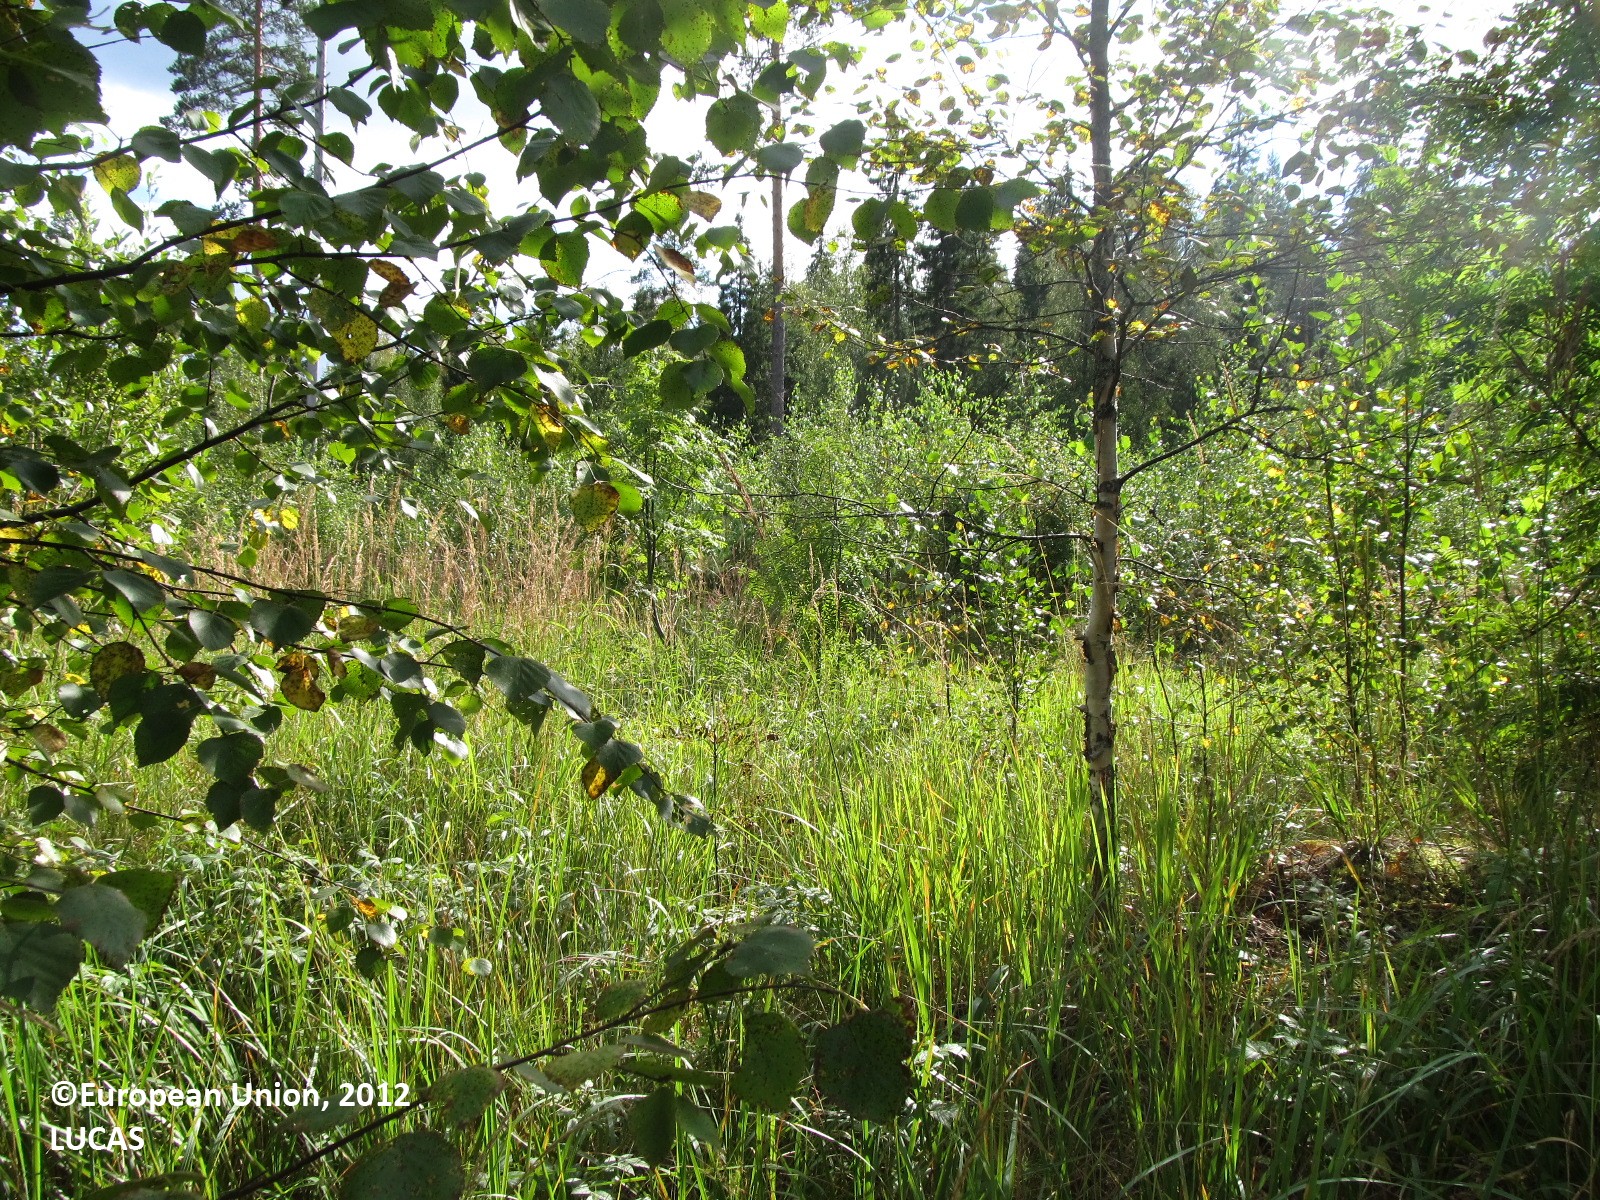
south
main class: Woodland
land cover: Broadleaved woodland
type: boreal forest
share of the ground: 50 - 75 %
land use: Forestry
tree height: < 5 m
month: August
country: FI
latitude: 62.0150
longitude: 27.5384
